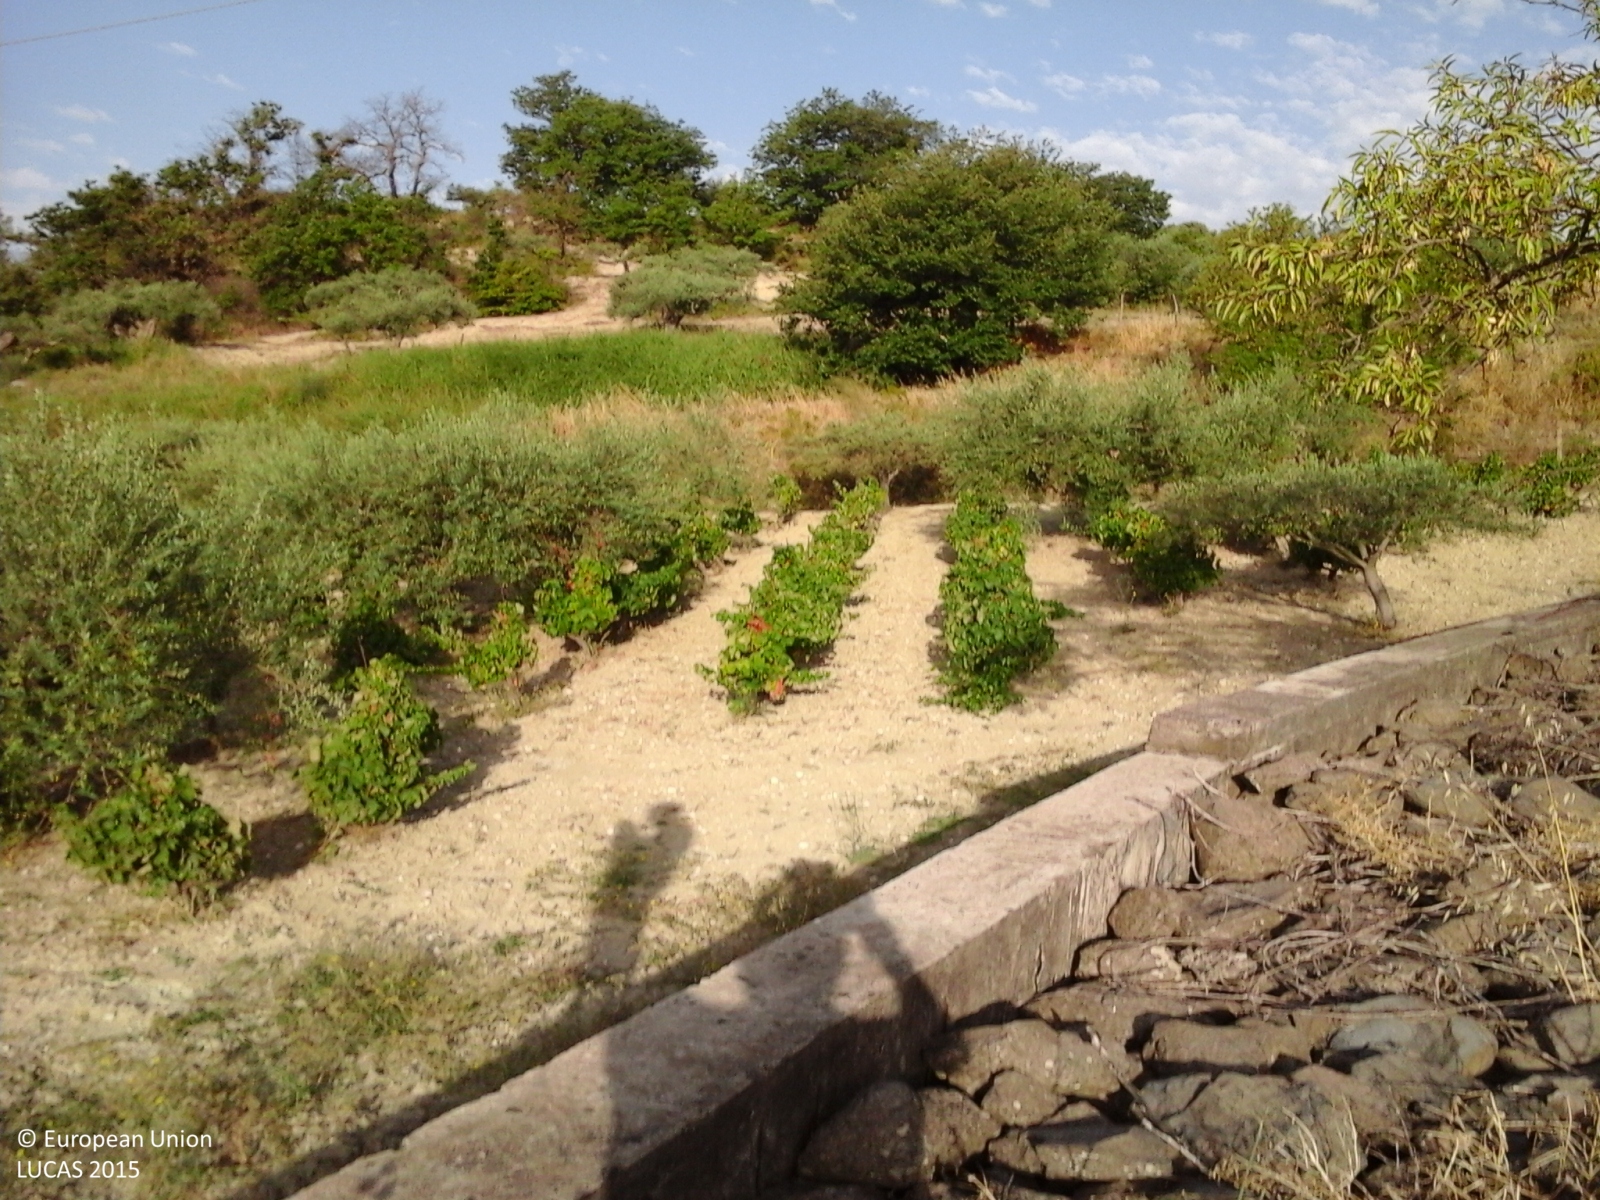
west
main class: Grassland
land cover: Spontaneously vegetated surfaces
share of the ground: 10 - 25 %
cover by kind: unconsolidated bare surface 75 %, herbaceous plants 25 %
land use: Agriculture (excluding fallow land and kitchen gardens)
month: August
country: IT
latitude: 37.1538
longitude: 14.7937
